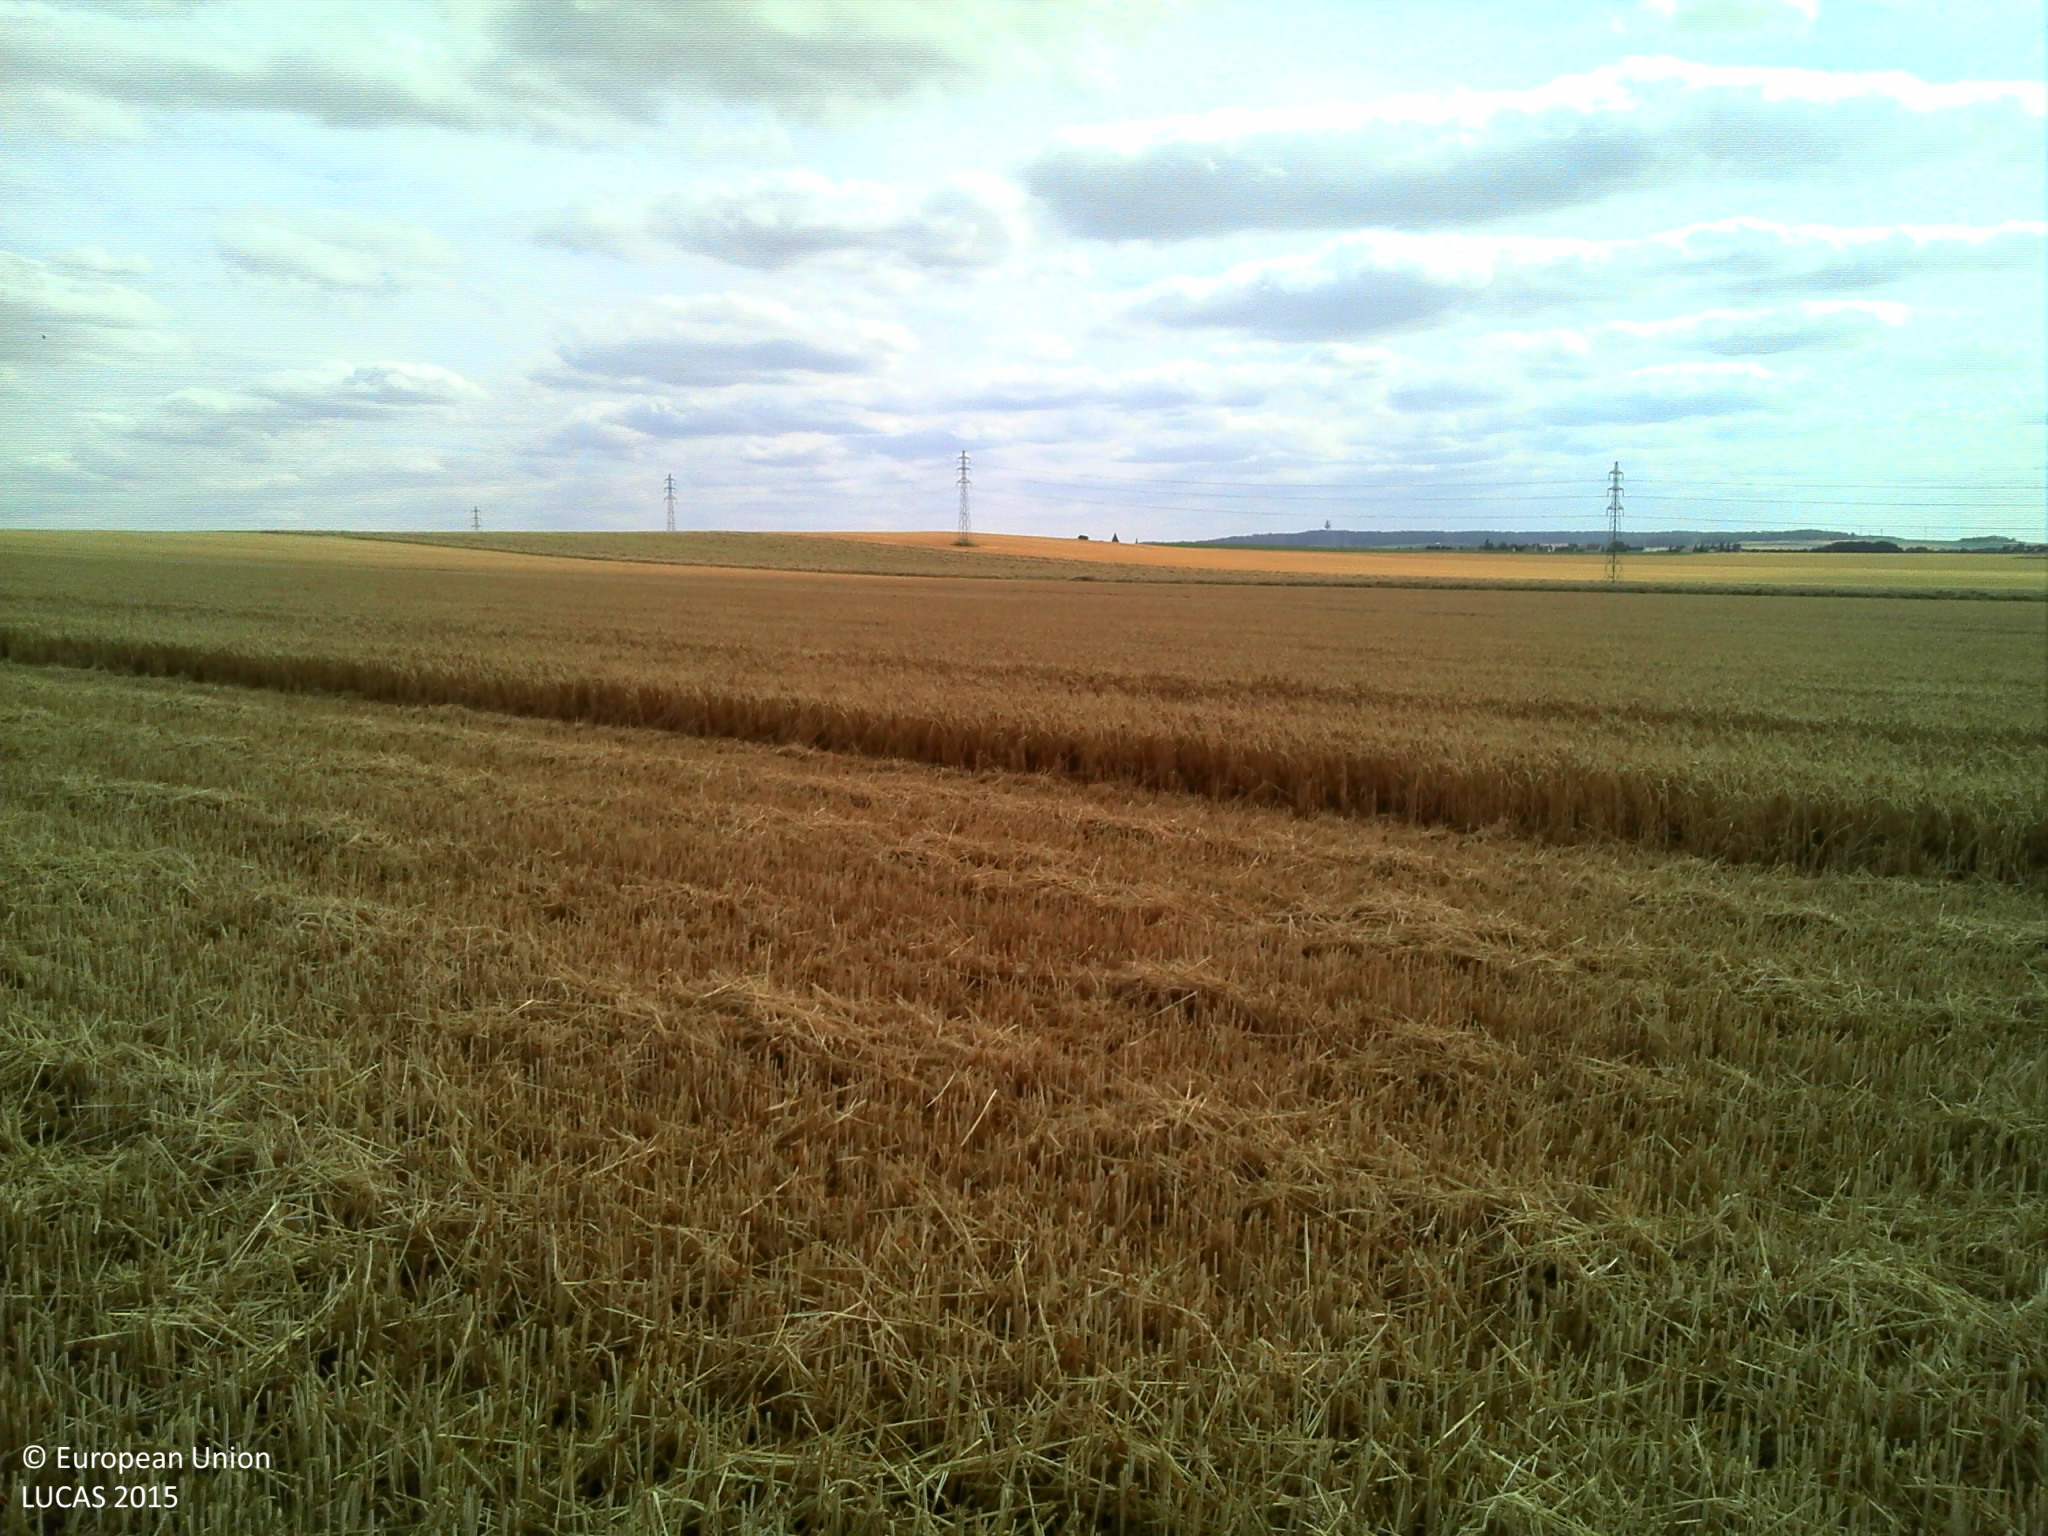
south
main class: Cropland
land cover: Common wheat
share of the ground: > 75 %
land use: Agriculture (excluding fallow land and kitchen gardens)
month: July
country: FR
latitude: 49.3321
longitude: 4.1746
